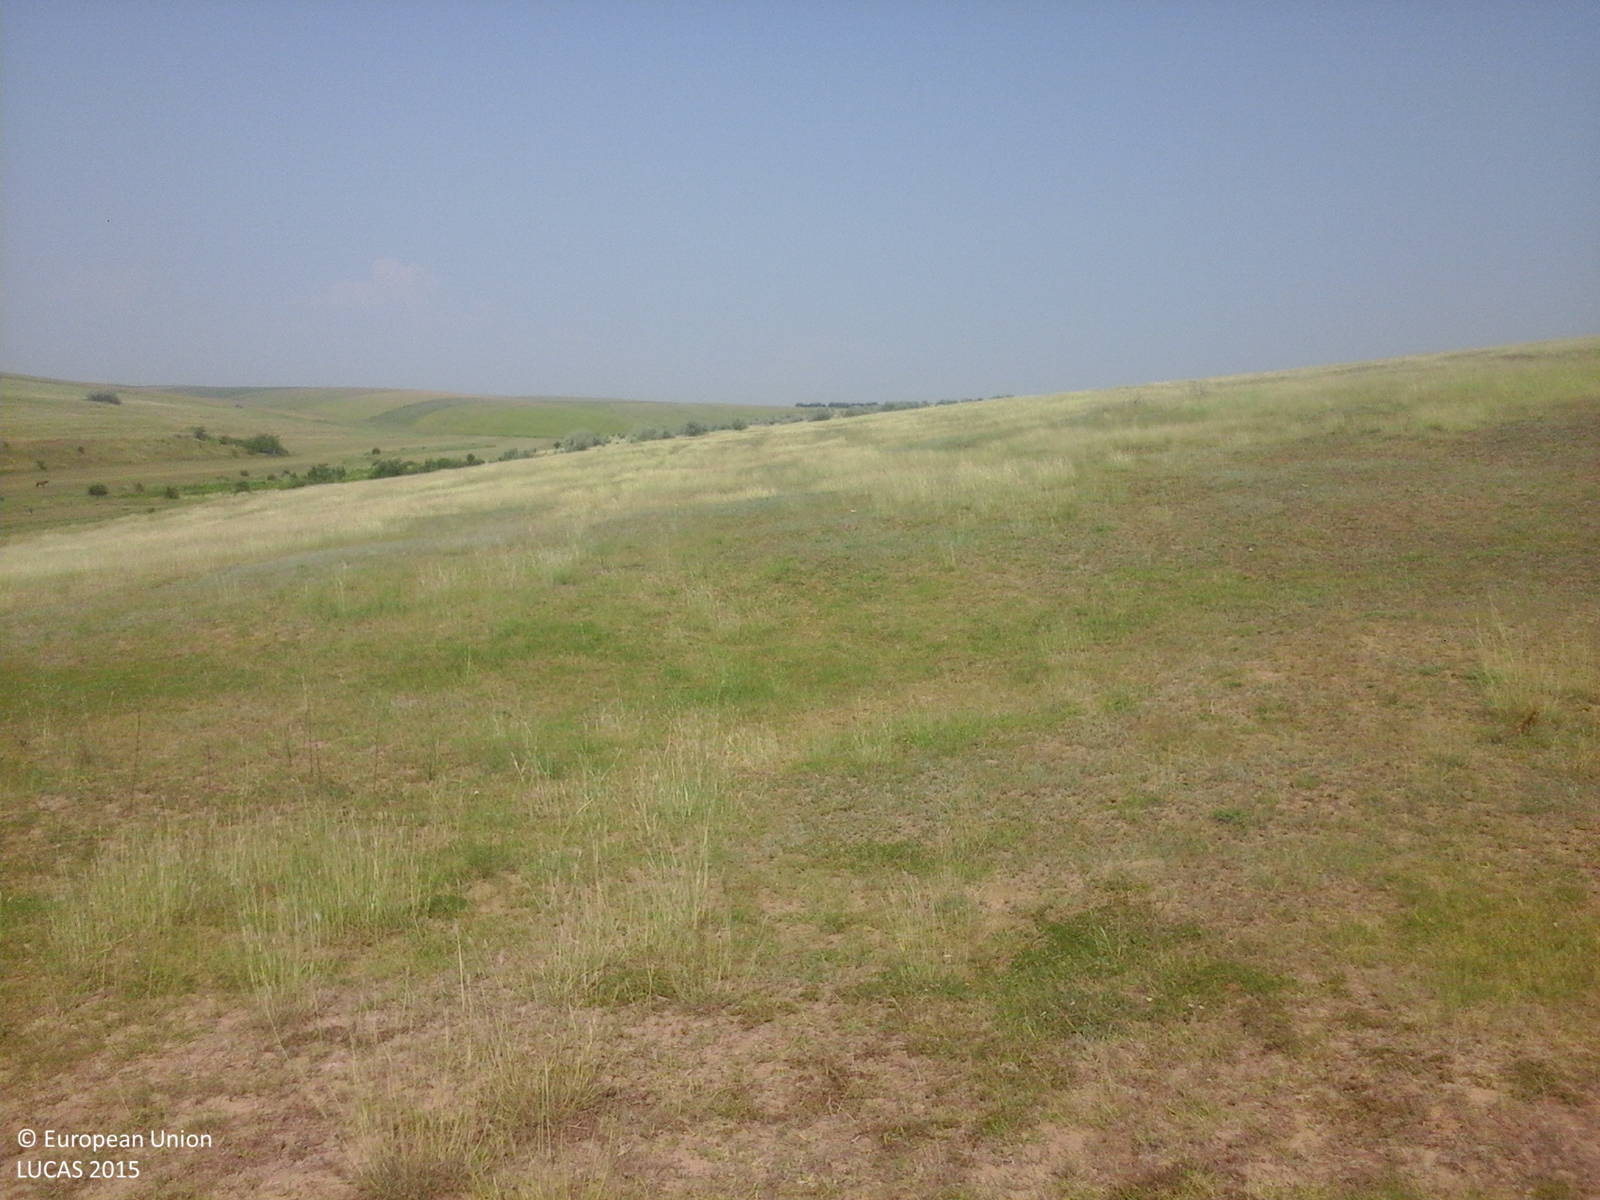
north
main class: Grassland
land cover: Grassland without tree/shrub cover
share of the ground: 50 - 75 %
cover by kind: herbaceous plants 100 %
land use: Agriculture (excluding fallow land and kitchen gardens)
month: July
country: RO
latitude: 45.8830
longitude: 27.9662
